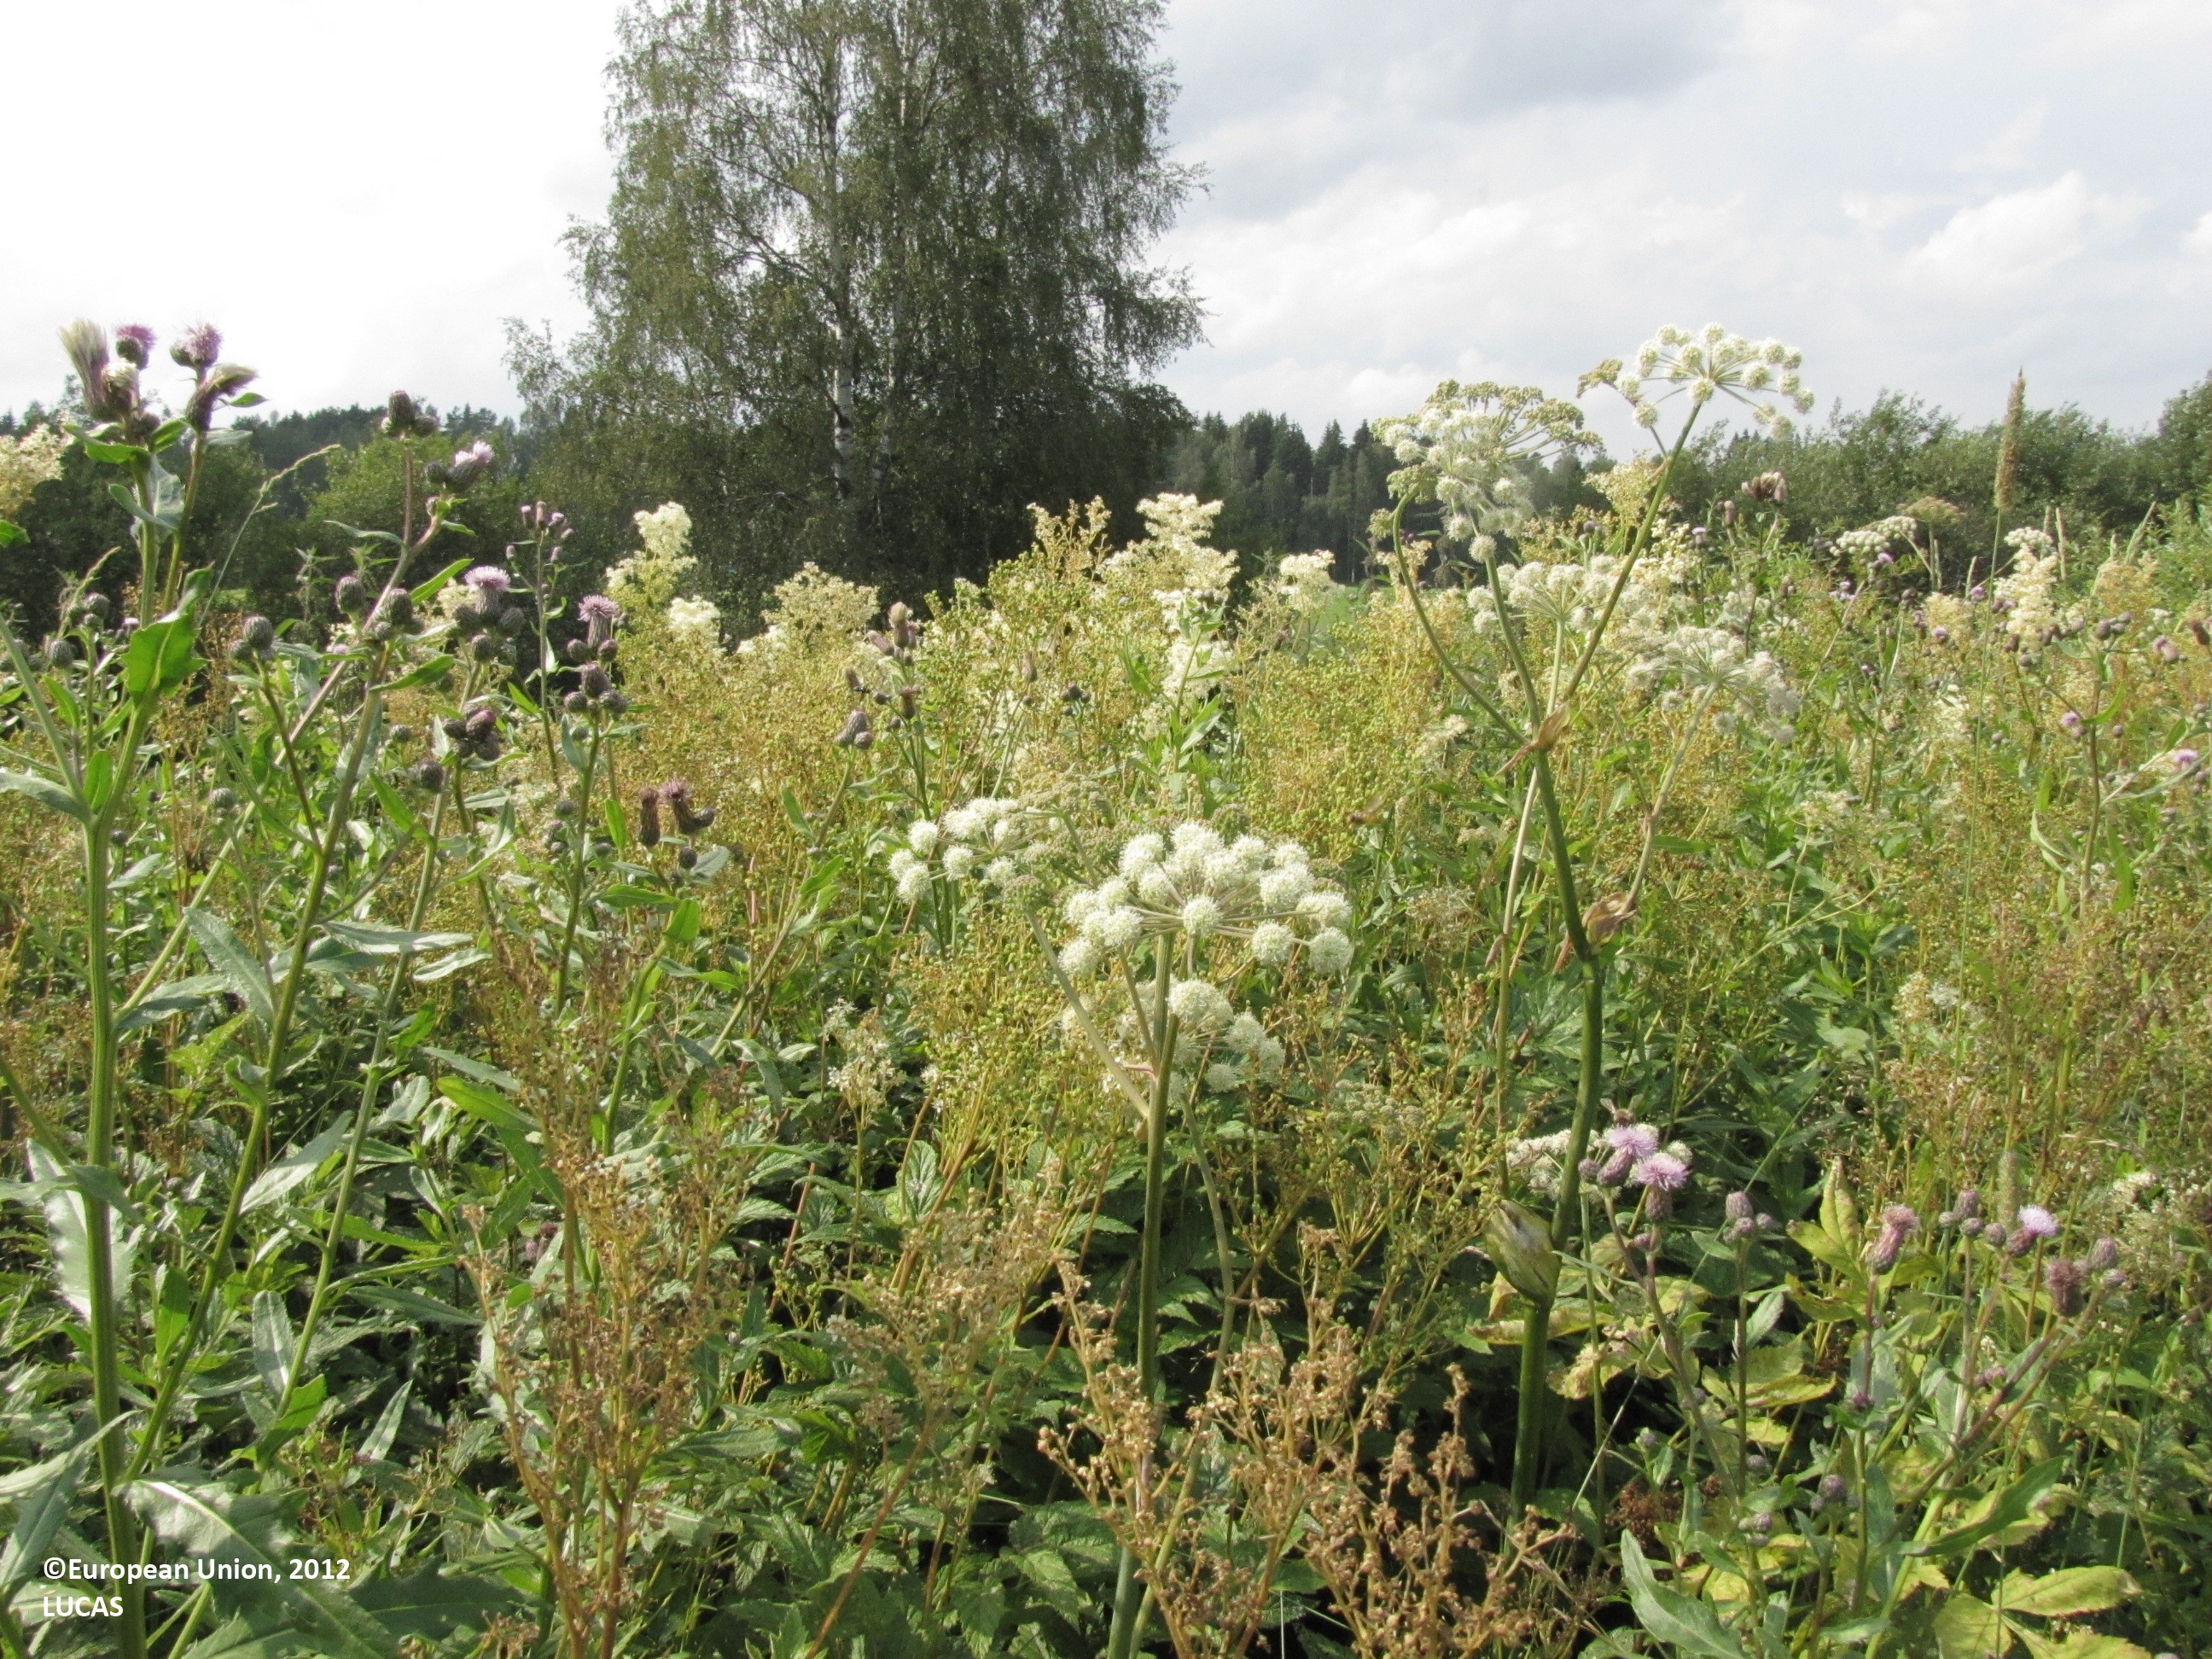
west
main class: Cropland
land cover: Temporary grasslands
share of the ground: > 75 %
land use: Agriculture (excluding fallow land and kitchen gardens)
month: July
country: FI
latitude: 62.0061
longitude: 23.0349
